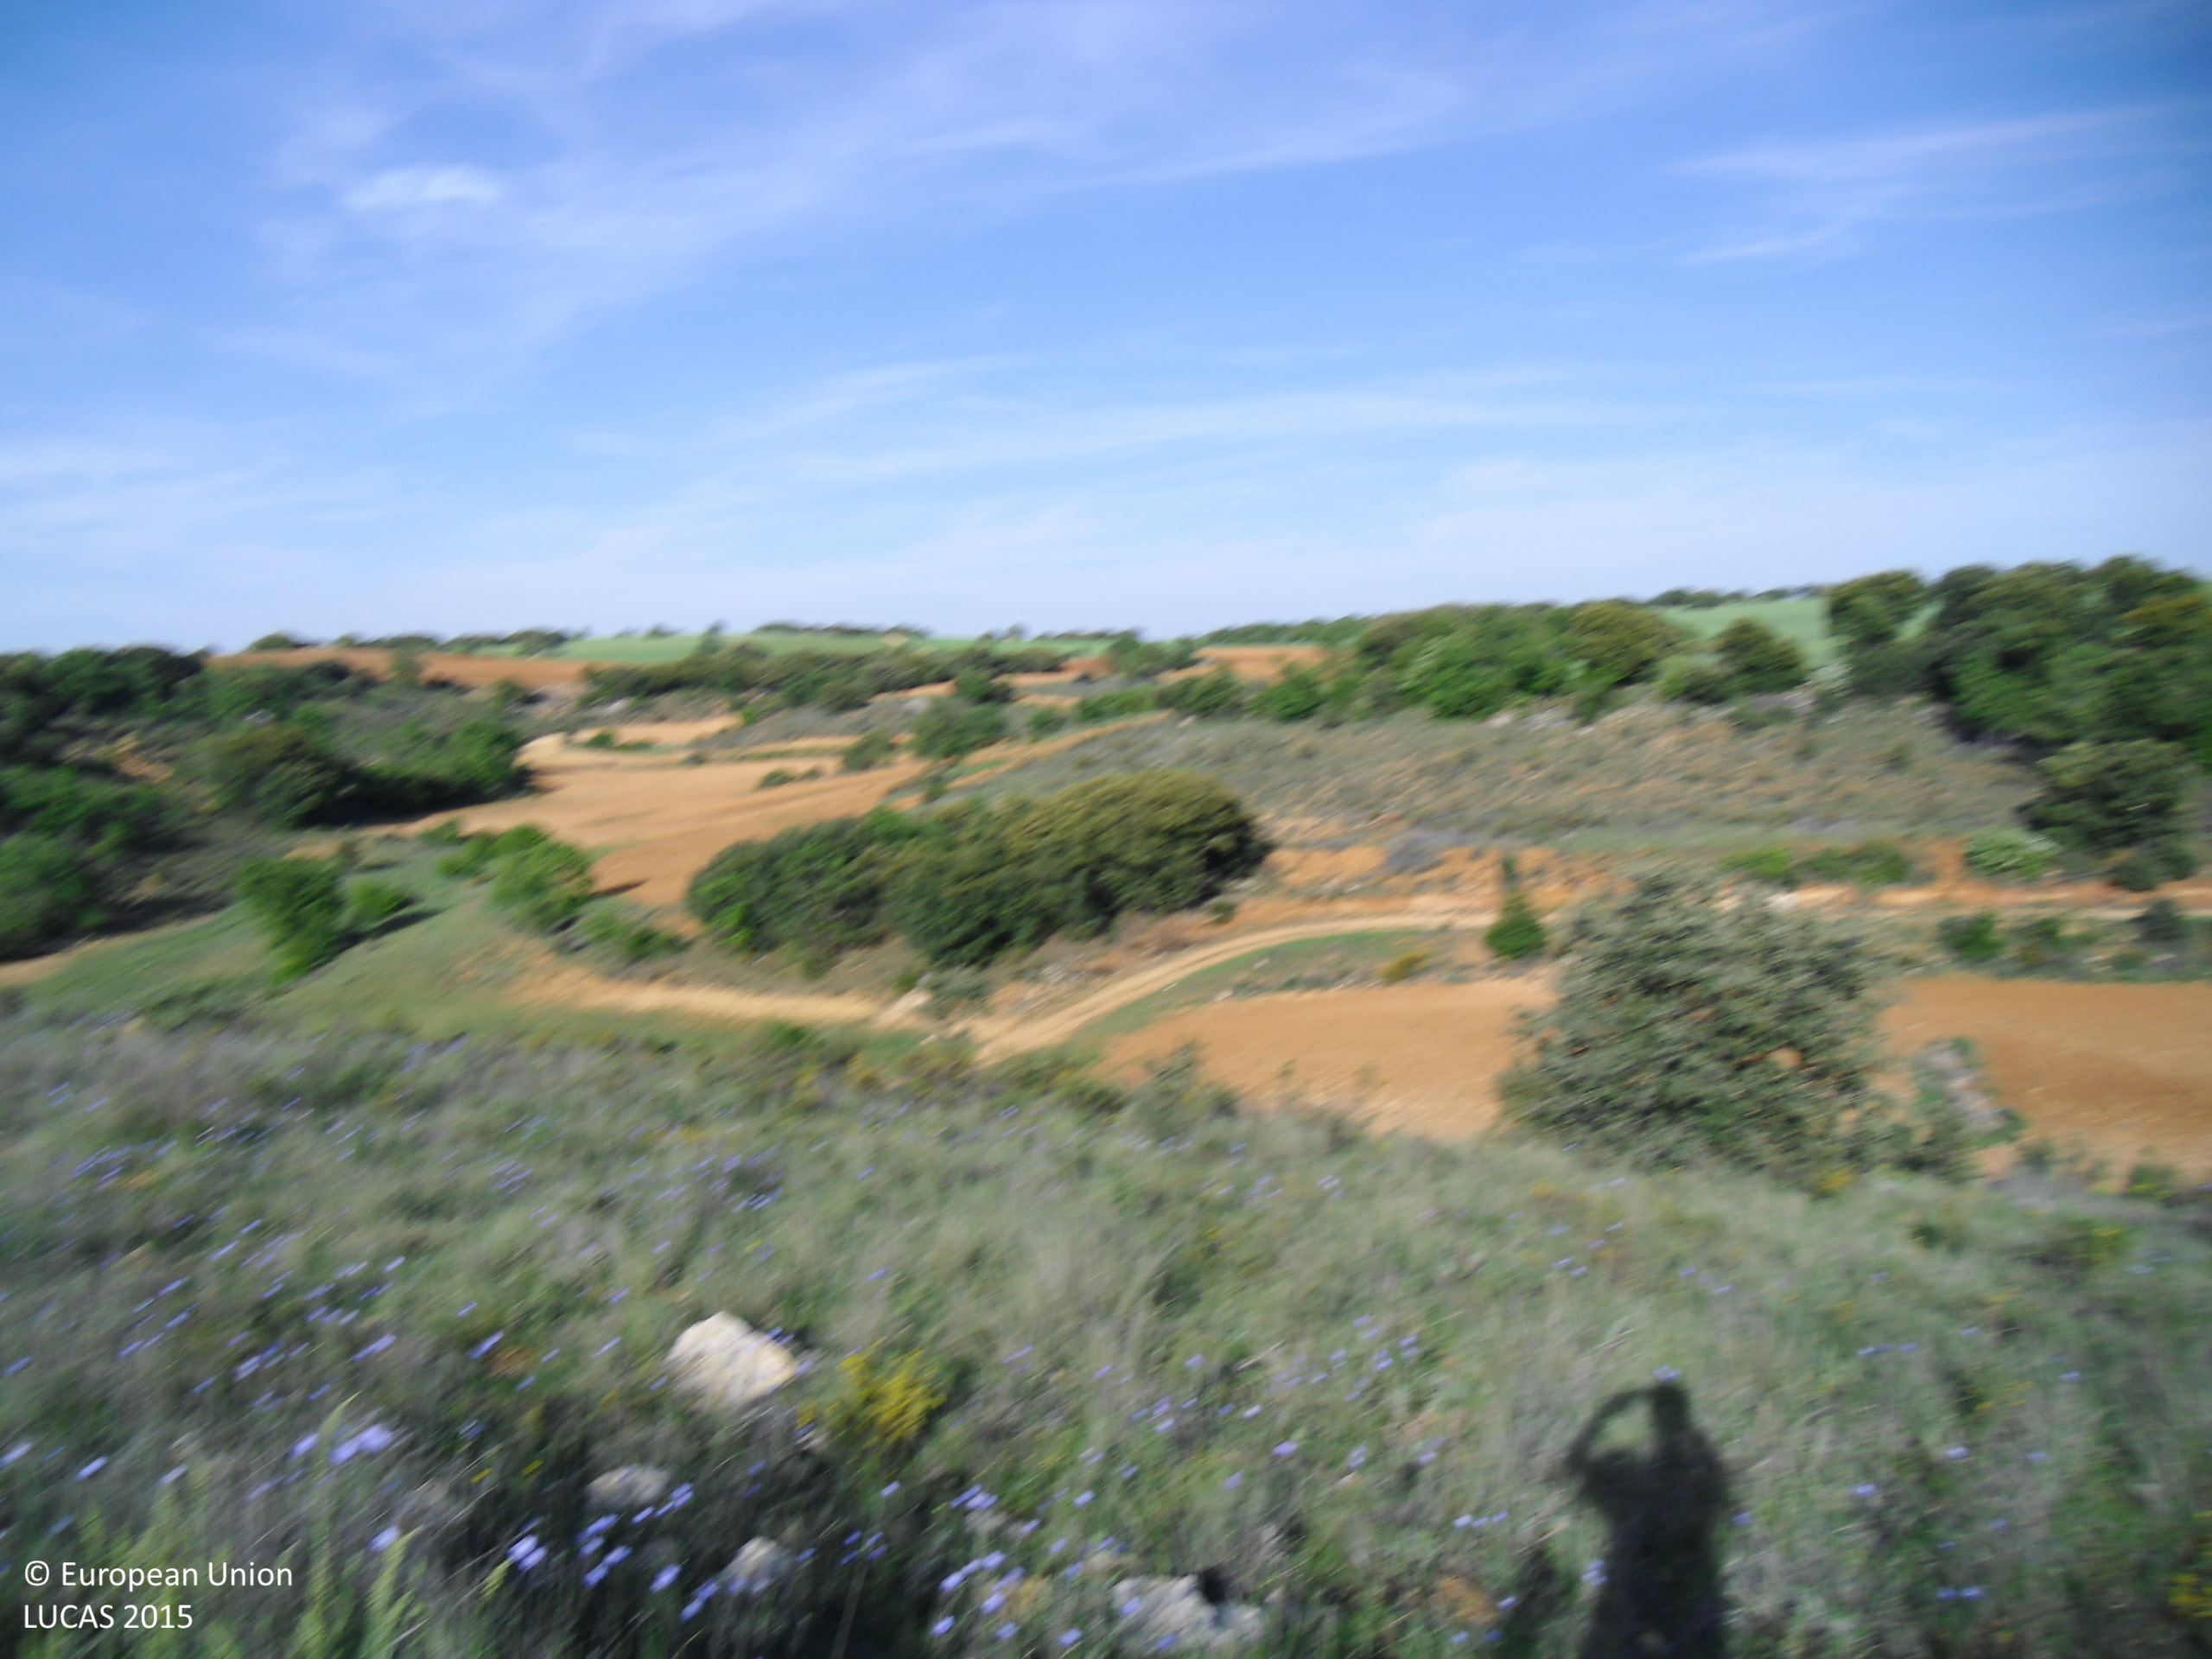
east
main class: Grassland
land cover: Grassland with sparse tree/shrub cover
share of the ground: > 75 %
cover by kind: herbaceous plants 90 %, coniferous forest trees 5 %, shrubs 5 %
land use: Semi-natural and natural areas not in use
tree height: < 5 m
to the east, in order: Grassland with sparse tree/shrub cover; Shrubland without tree cover; Other bare soil; Shruby margins; Tracks; Shrubland without tree cover; Abandoned hedges; Other bare soil; Grass margins; Other bare soil; Broadleaved woodland
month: May
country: ES
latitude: 40.5236
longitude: -2.9310
